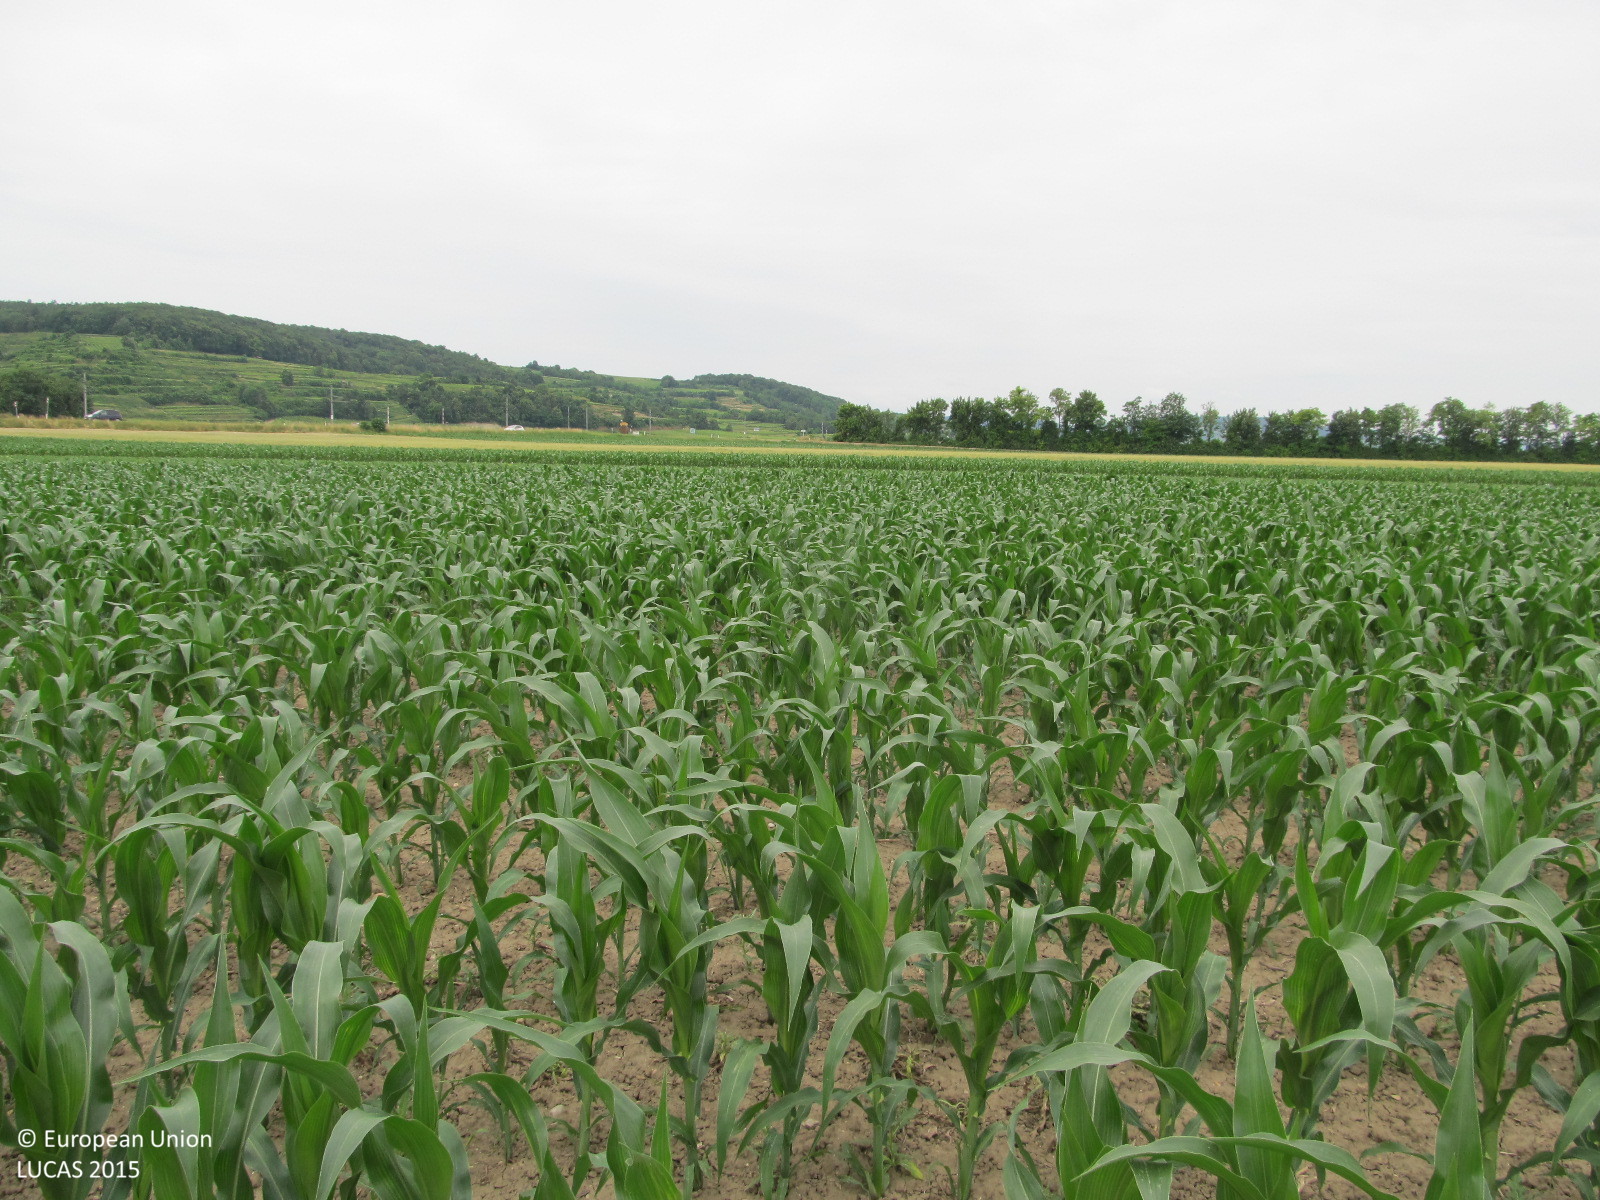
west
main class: Cropland
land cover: Barley
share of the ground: > 75 %
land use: Agriculture (excluding fallow land and kitchen gardens)
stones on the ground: < 10 %
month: June
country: AT
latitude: 48.3419
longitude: 15.7913
